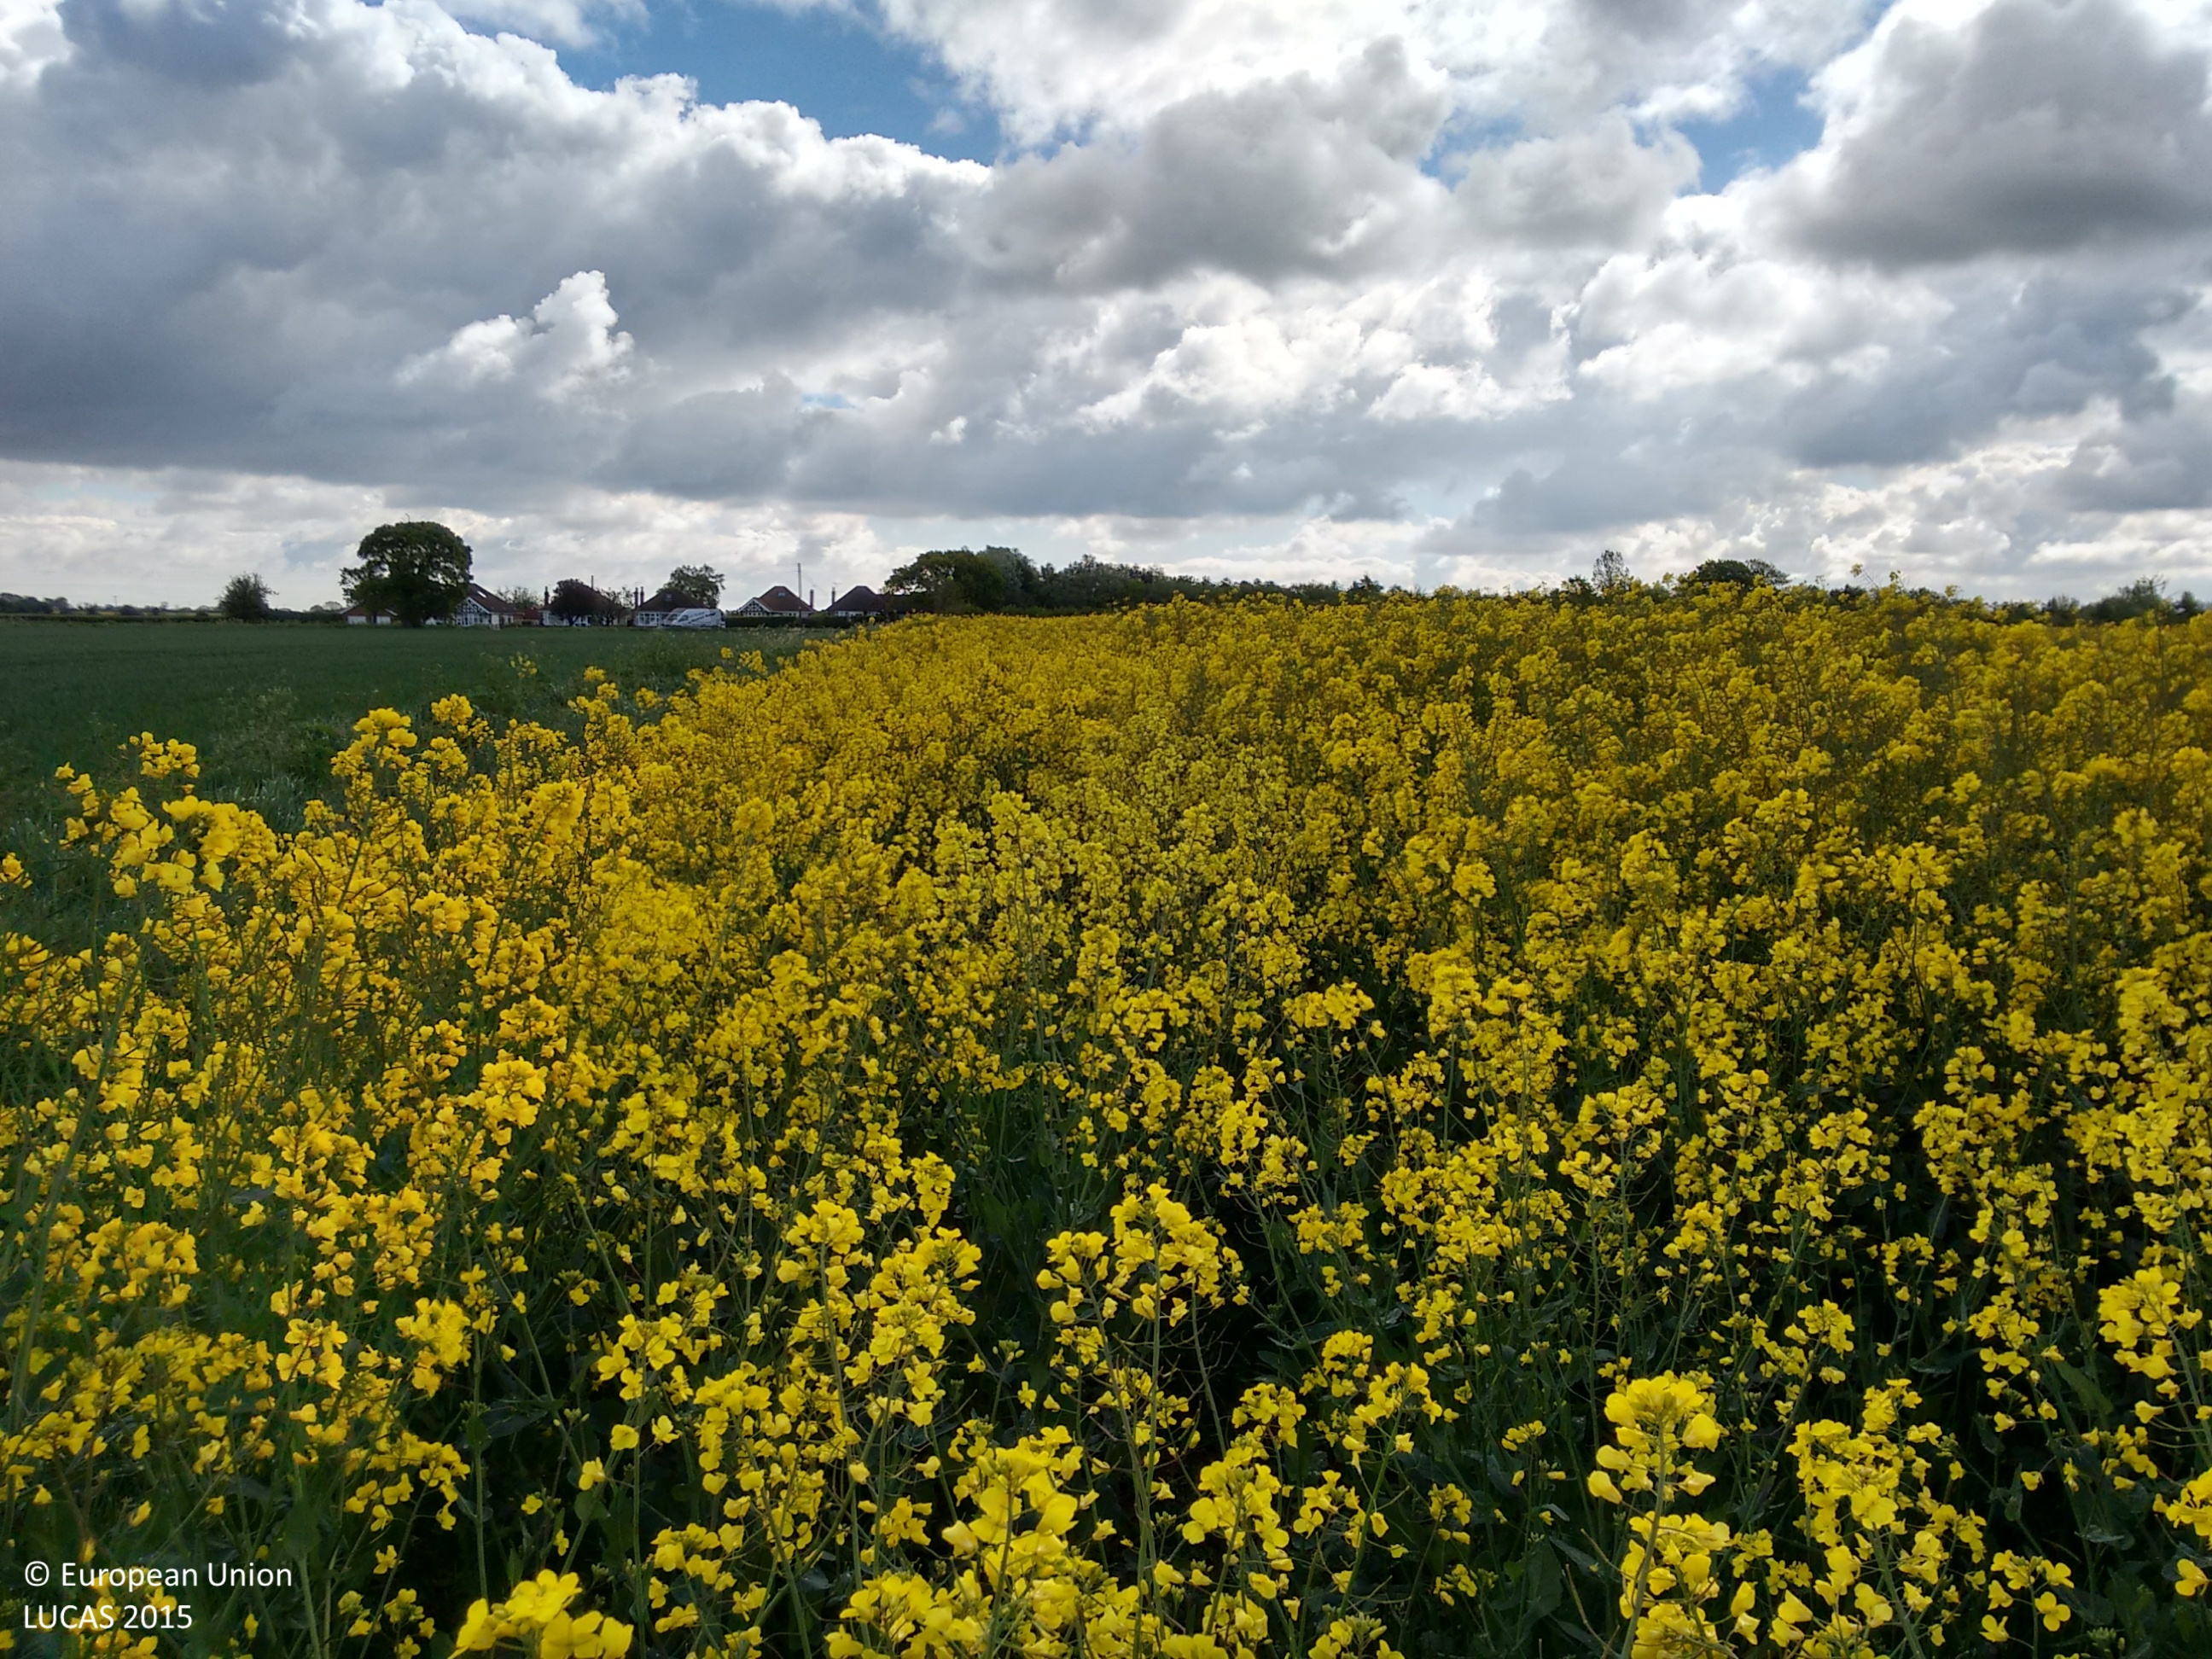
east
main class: Cropland
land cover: Rape and turnip rape
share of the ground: > 75 %
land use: Agriculture (excluding fallow land and kitchen gardens)
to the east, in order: Rape and turnip rape; Grass margins; Managed hedges; Paved roads, cycling and walking lanes; Grass margins; Abandoned hedges
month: May
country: GB
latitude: 53.7666
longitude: -0.2133
